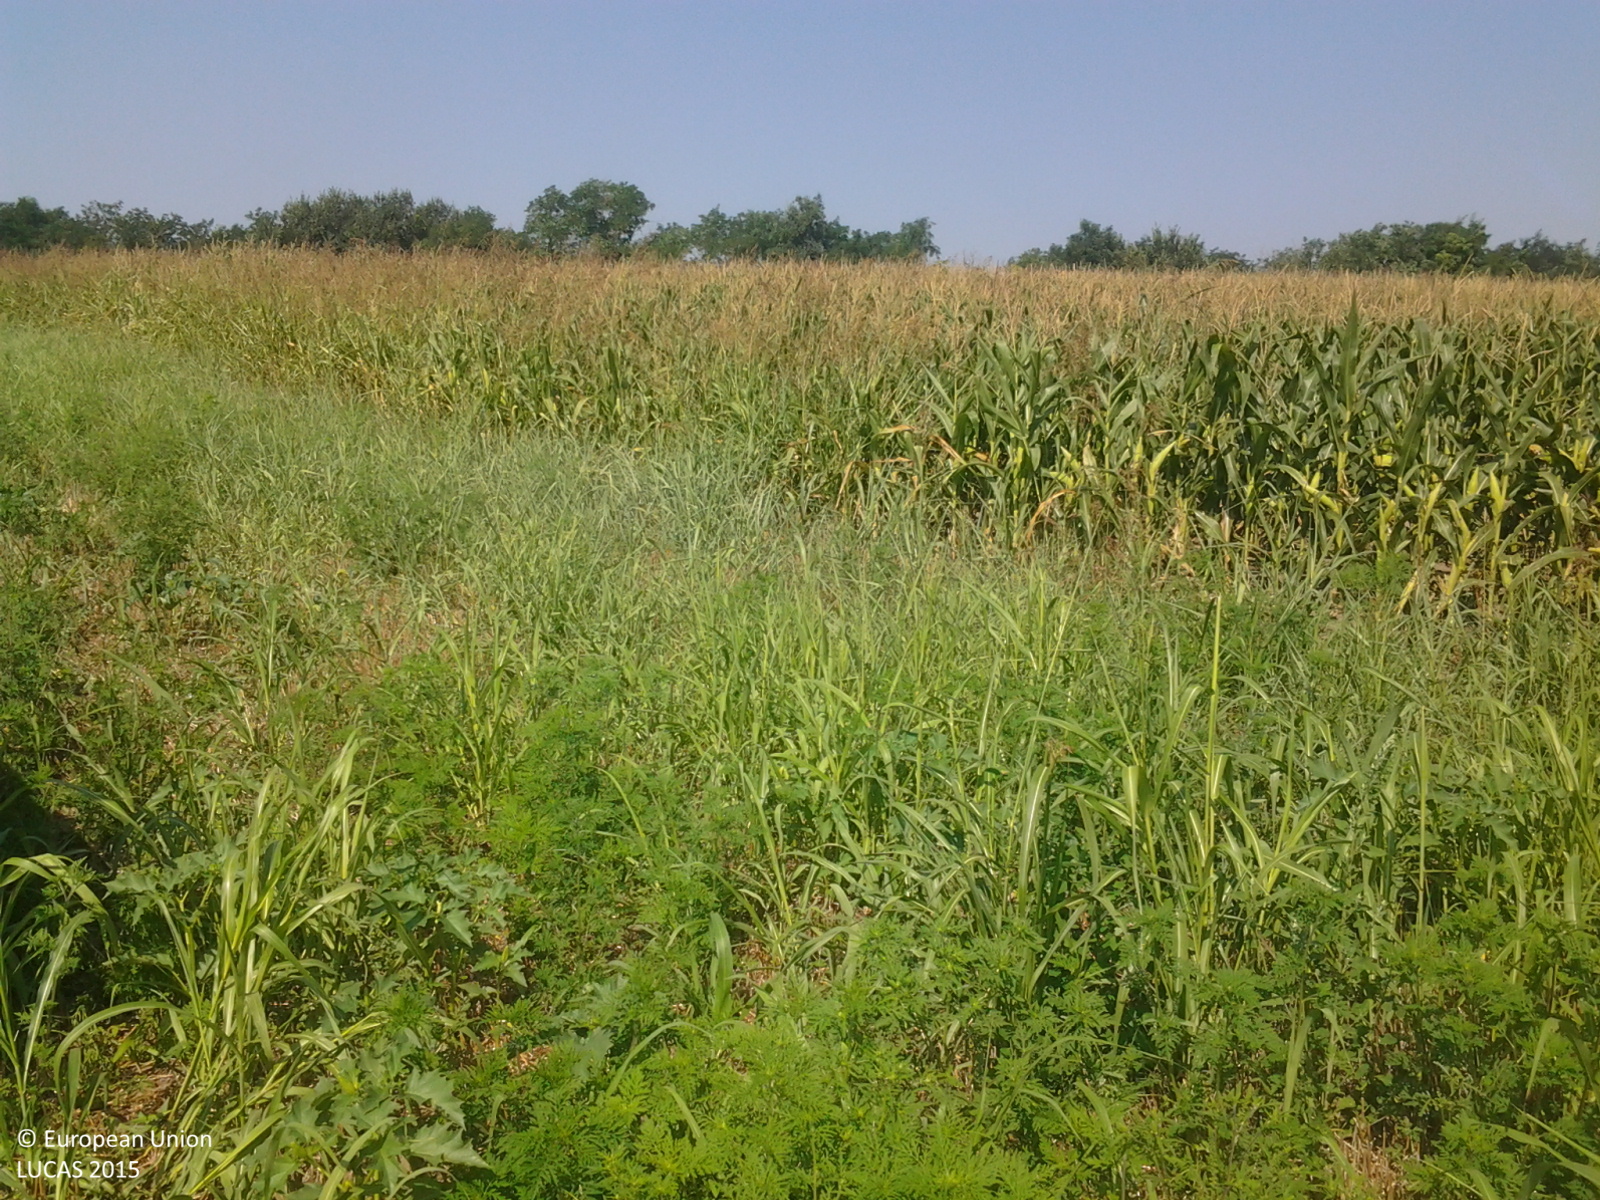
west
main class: Cropland
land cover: Common wheat
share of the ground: < 10 %
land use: Agriculture (excluding fallow land and kitchen gardens)
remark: Harvested field
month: August
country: HU
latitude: 46.7980
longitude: 18.4092
